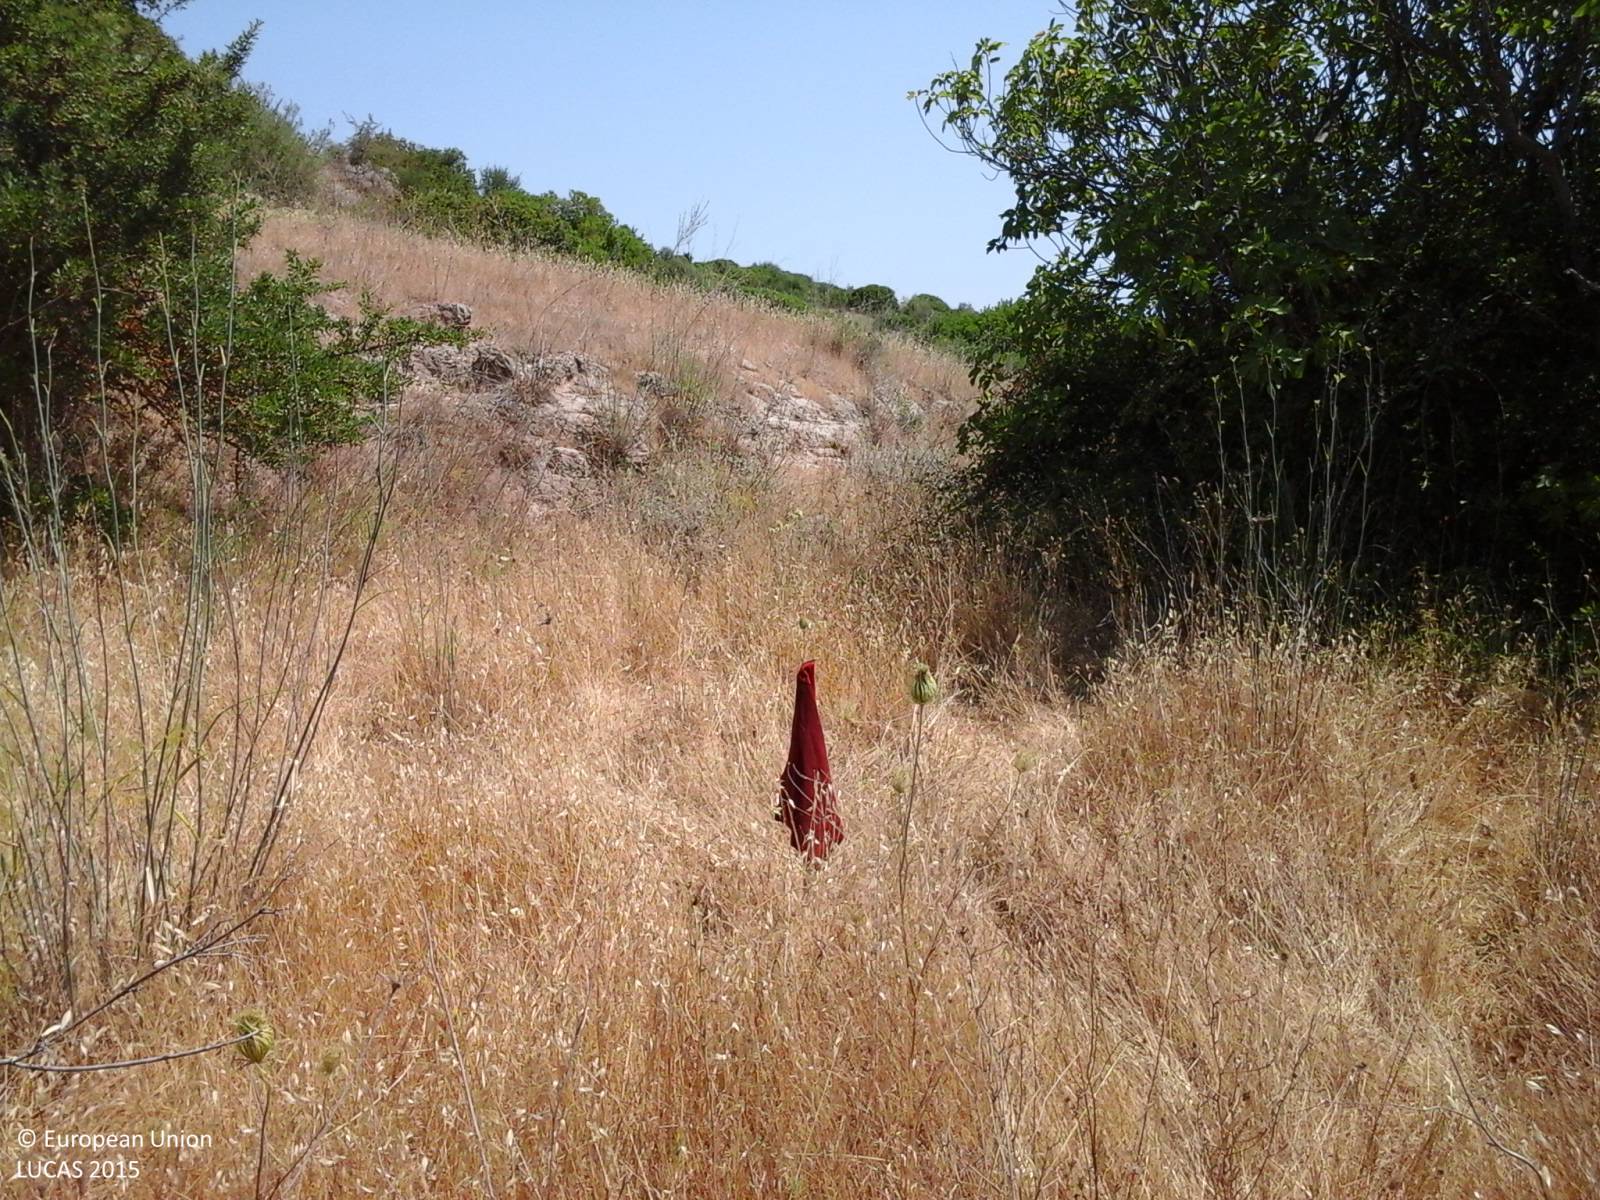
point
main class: Grassland
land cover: Grassland with sparse tree/shrub cover
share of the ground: > 75 %
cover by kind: herbaceous plants 80 %, shrubs 10 %, broadleaved forest trees 5 %, consolidated bare surface 5 %
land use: Agriculture (excluding fallow land and kitchen gardens)
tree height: < 5 m
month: July
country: IT
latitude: 40.8034
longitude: 8.8321
